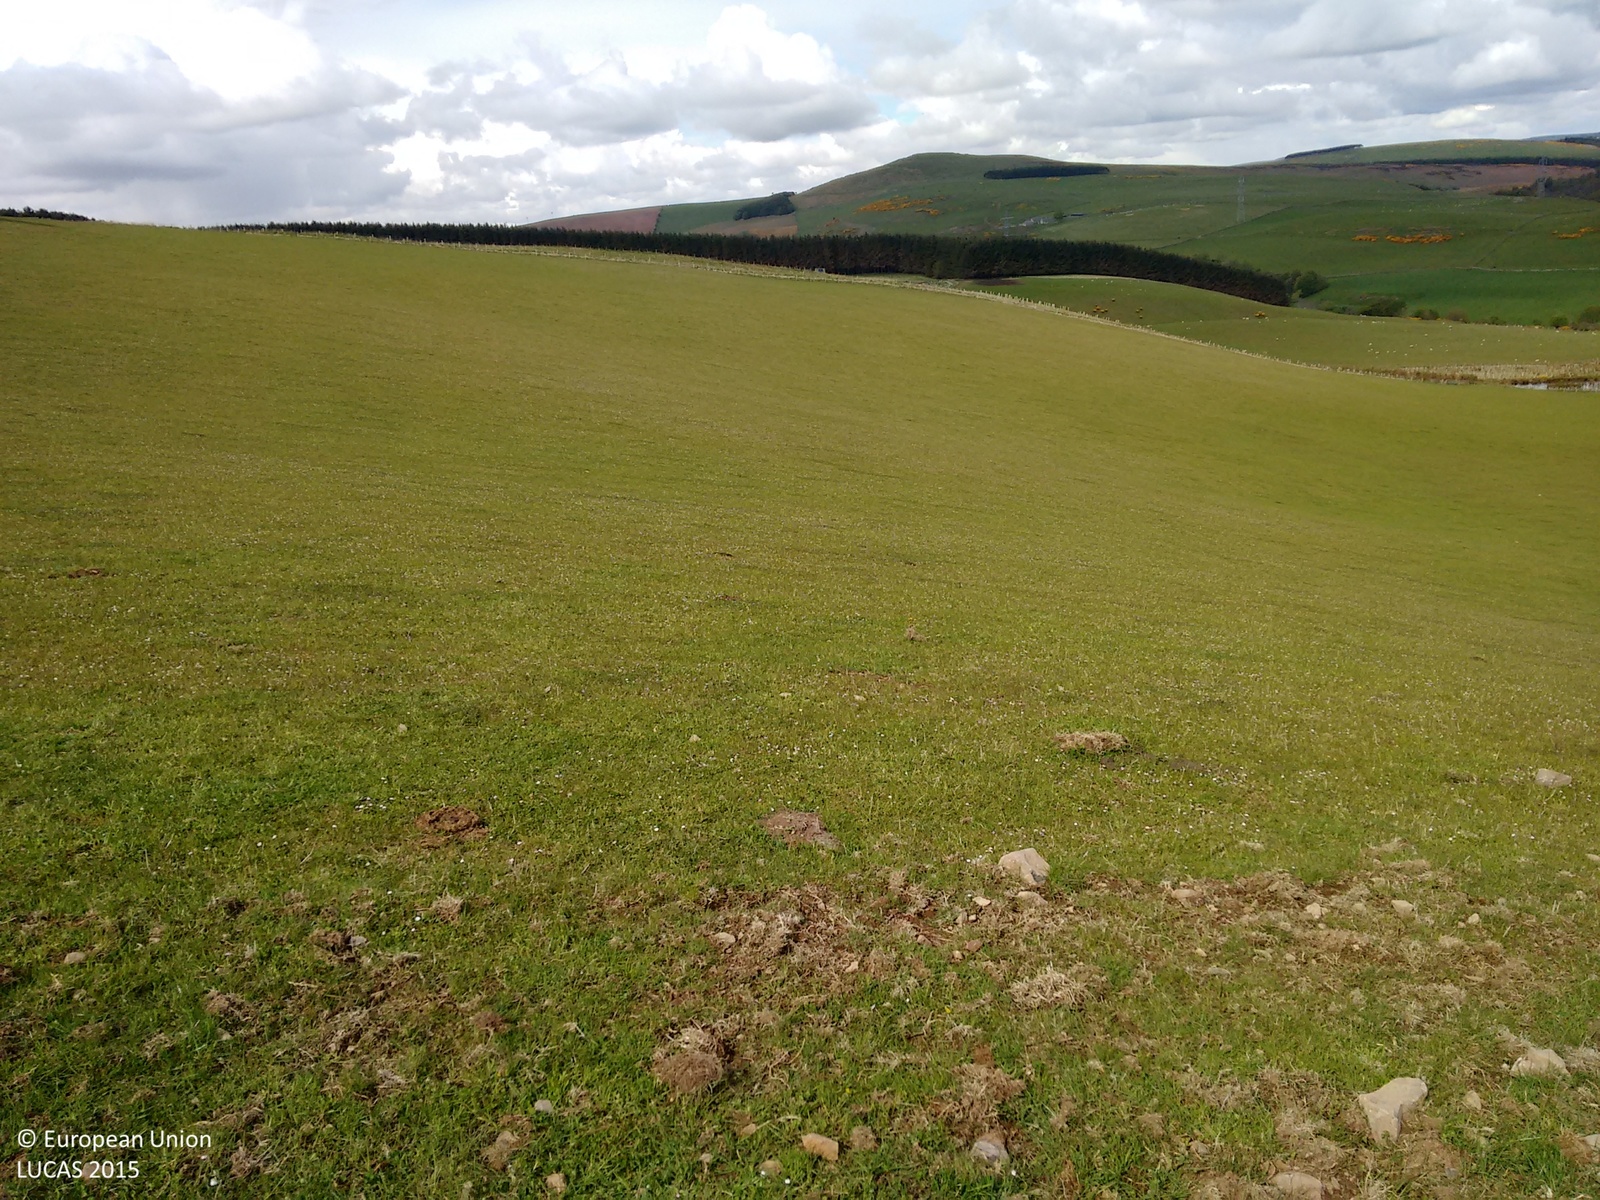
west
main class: Grassland
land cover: Grassland without tree/shrub cover
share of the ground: > 75 %
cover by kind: herbaceous plants 100 %
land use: Agriculture (excluding fallow land and kitchen gardens)
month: May
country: GB
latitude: 55.8268
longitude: -2.3329
